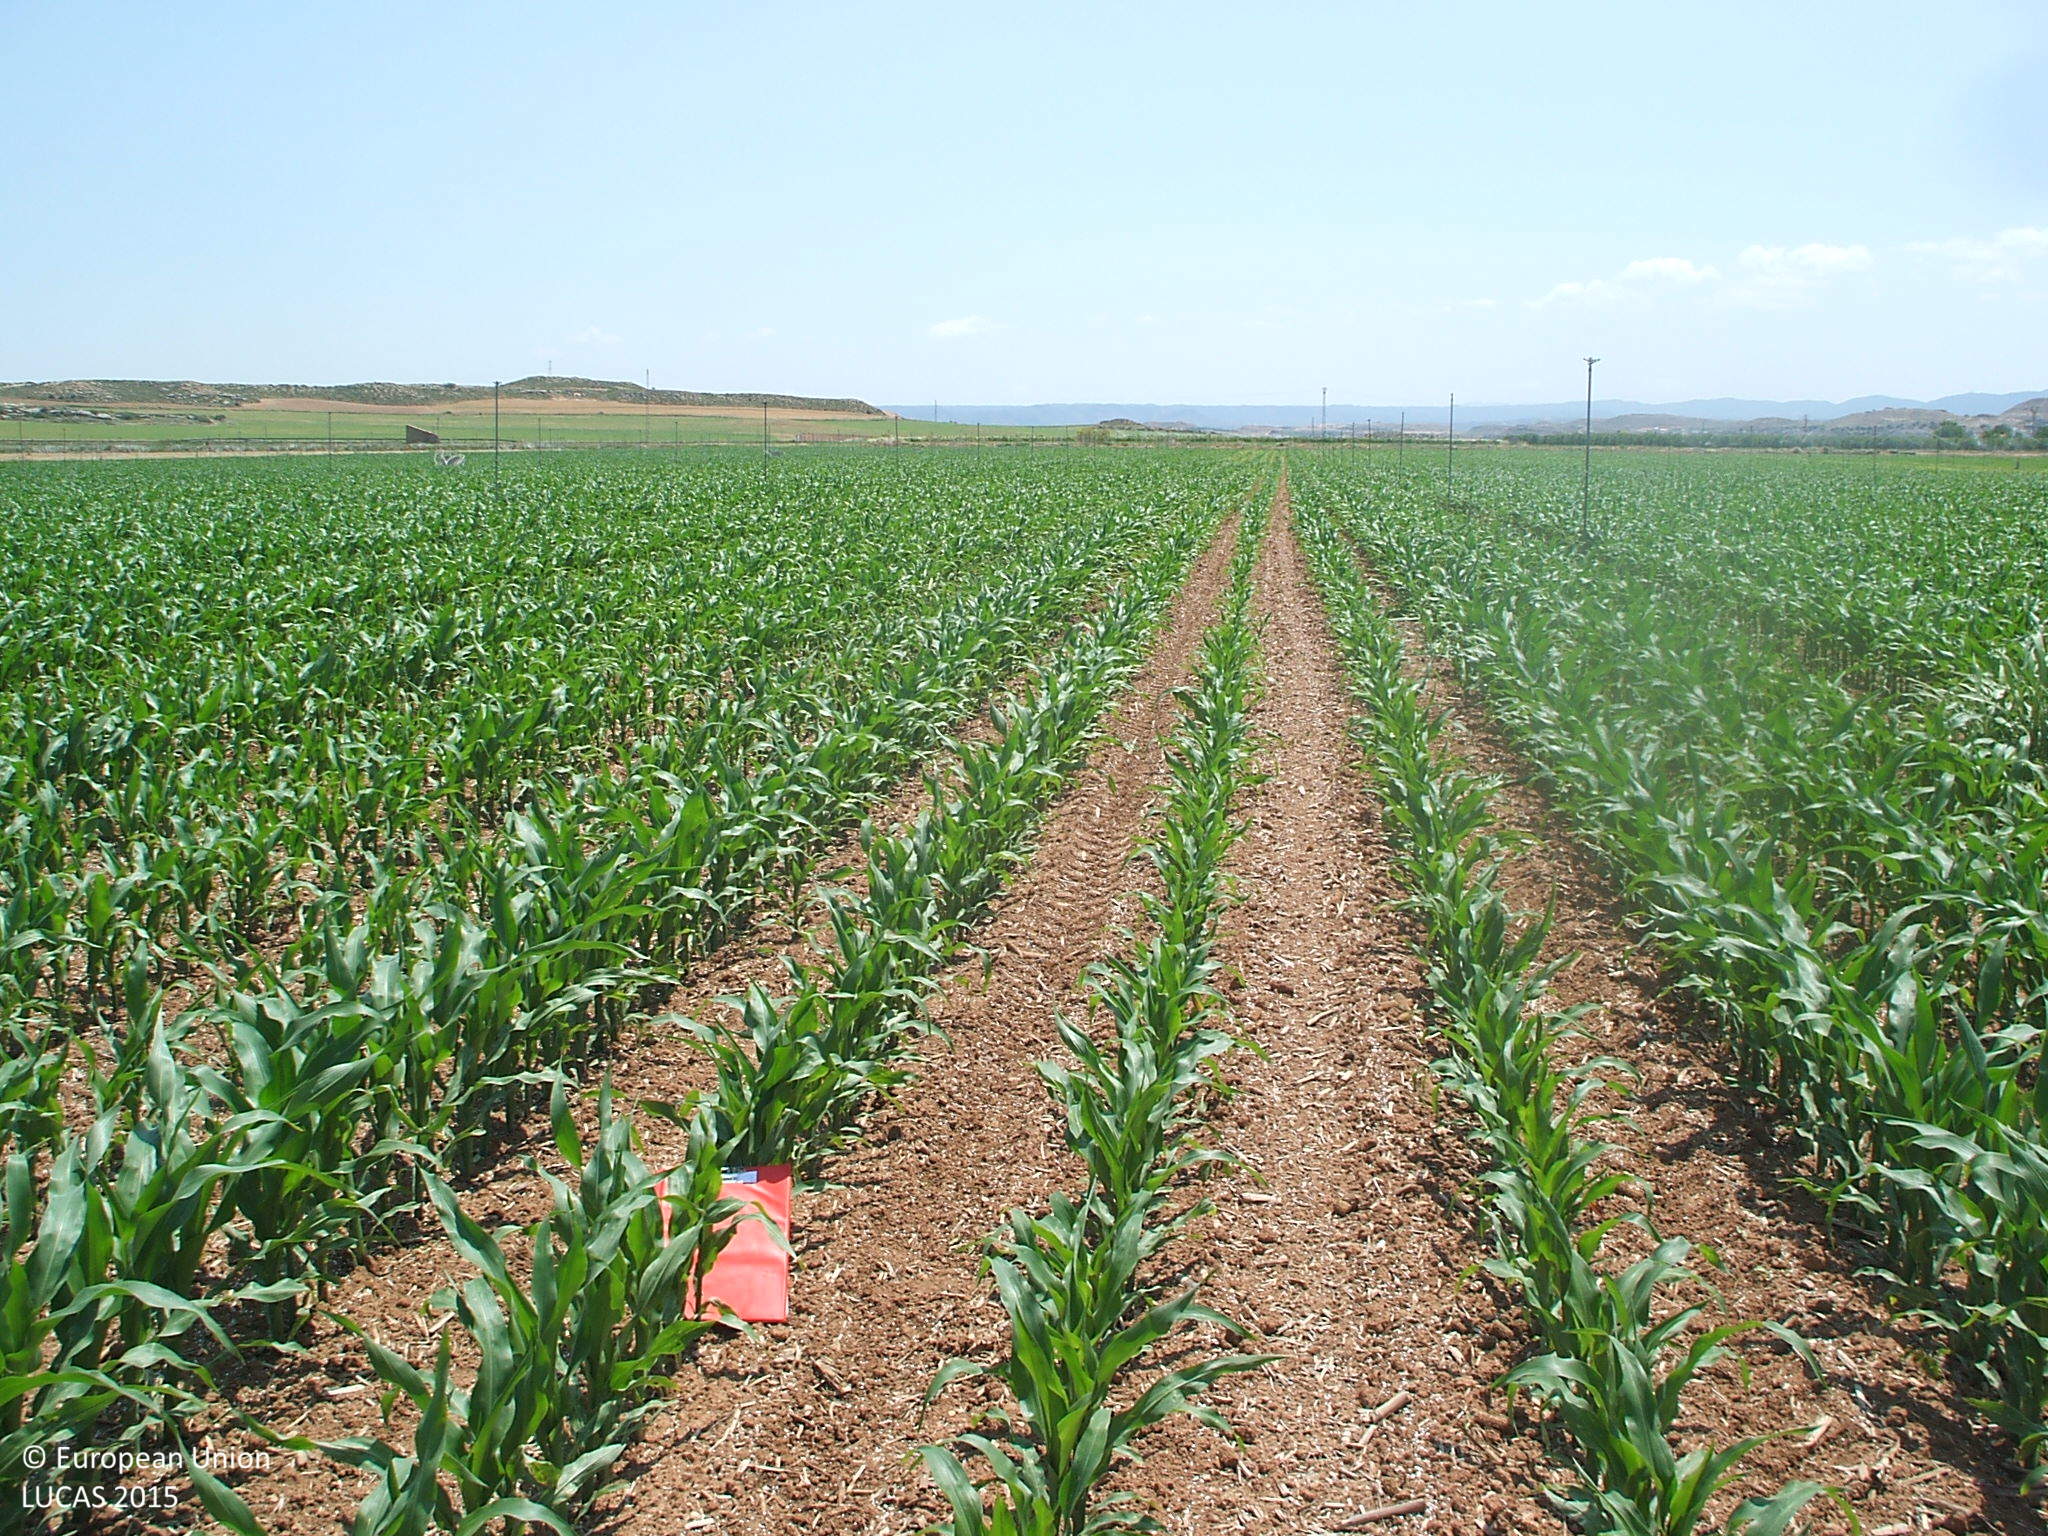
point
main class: Cropland
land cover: Maize
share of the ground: 50 - 75 %
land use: Agriculture (excluding fallow land and kitchen gardens)
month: June
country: ES
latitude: 41.0273
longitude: -0.2042
